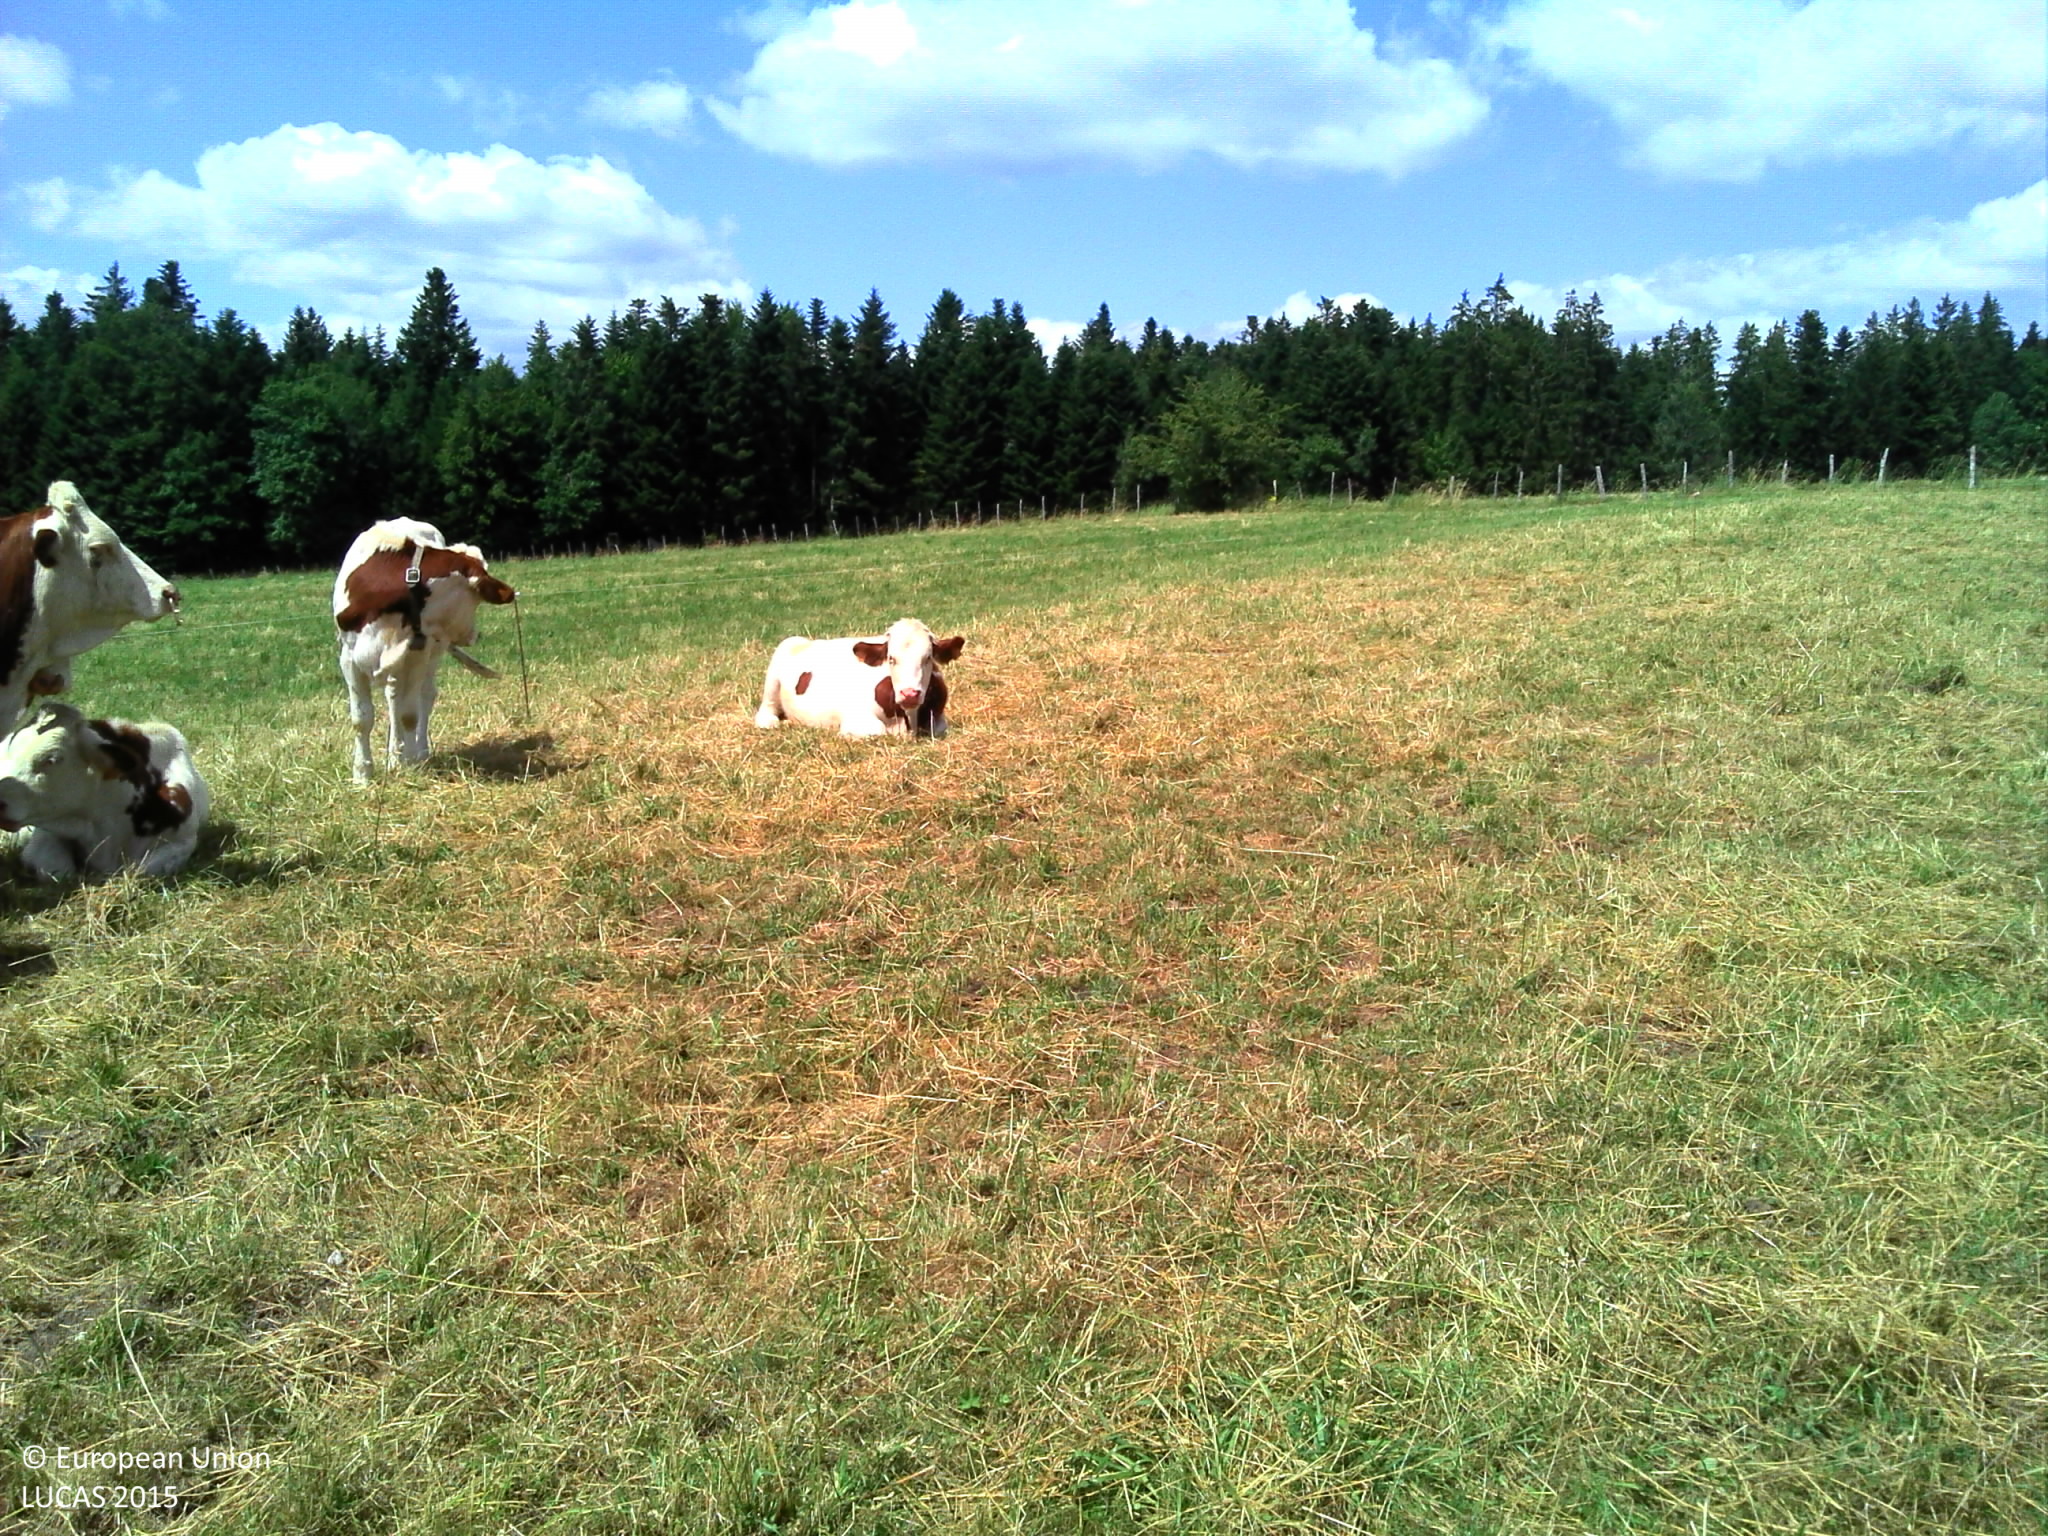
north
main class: Grassland
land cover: Grassland without tree/shrub cover
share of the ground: > 75 %
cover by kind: herbaceous plants 100 %
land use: Agriculture (excluding fallow land and kitchen gardens)
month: July
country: FR
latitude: 46.8374
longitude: 6.0558
